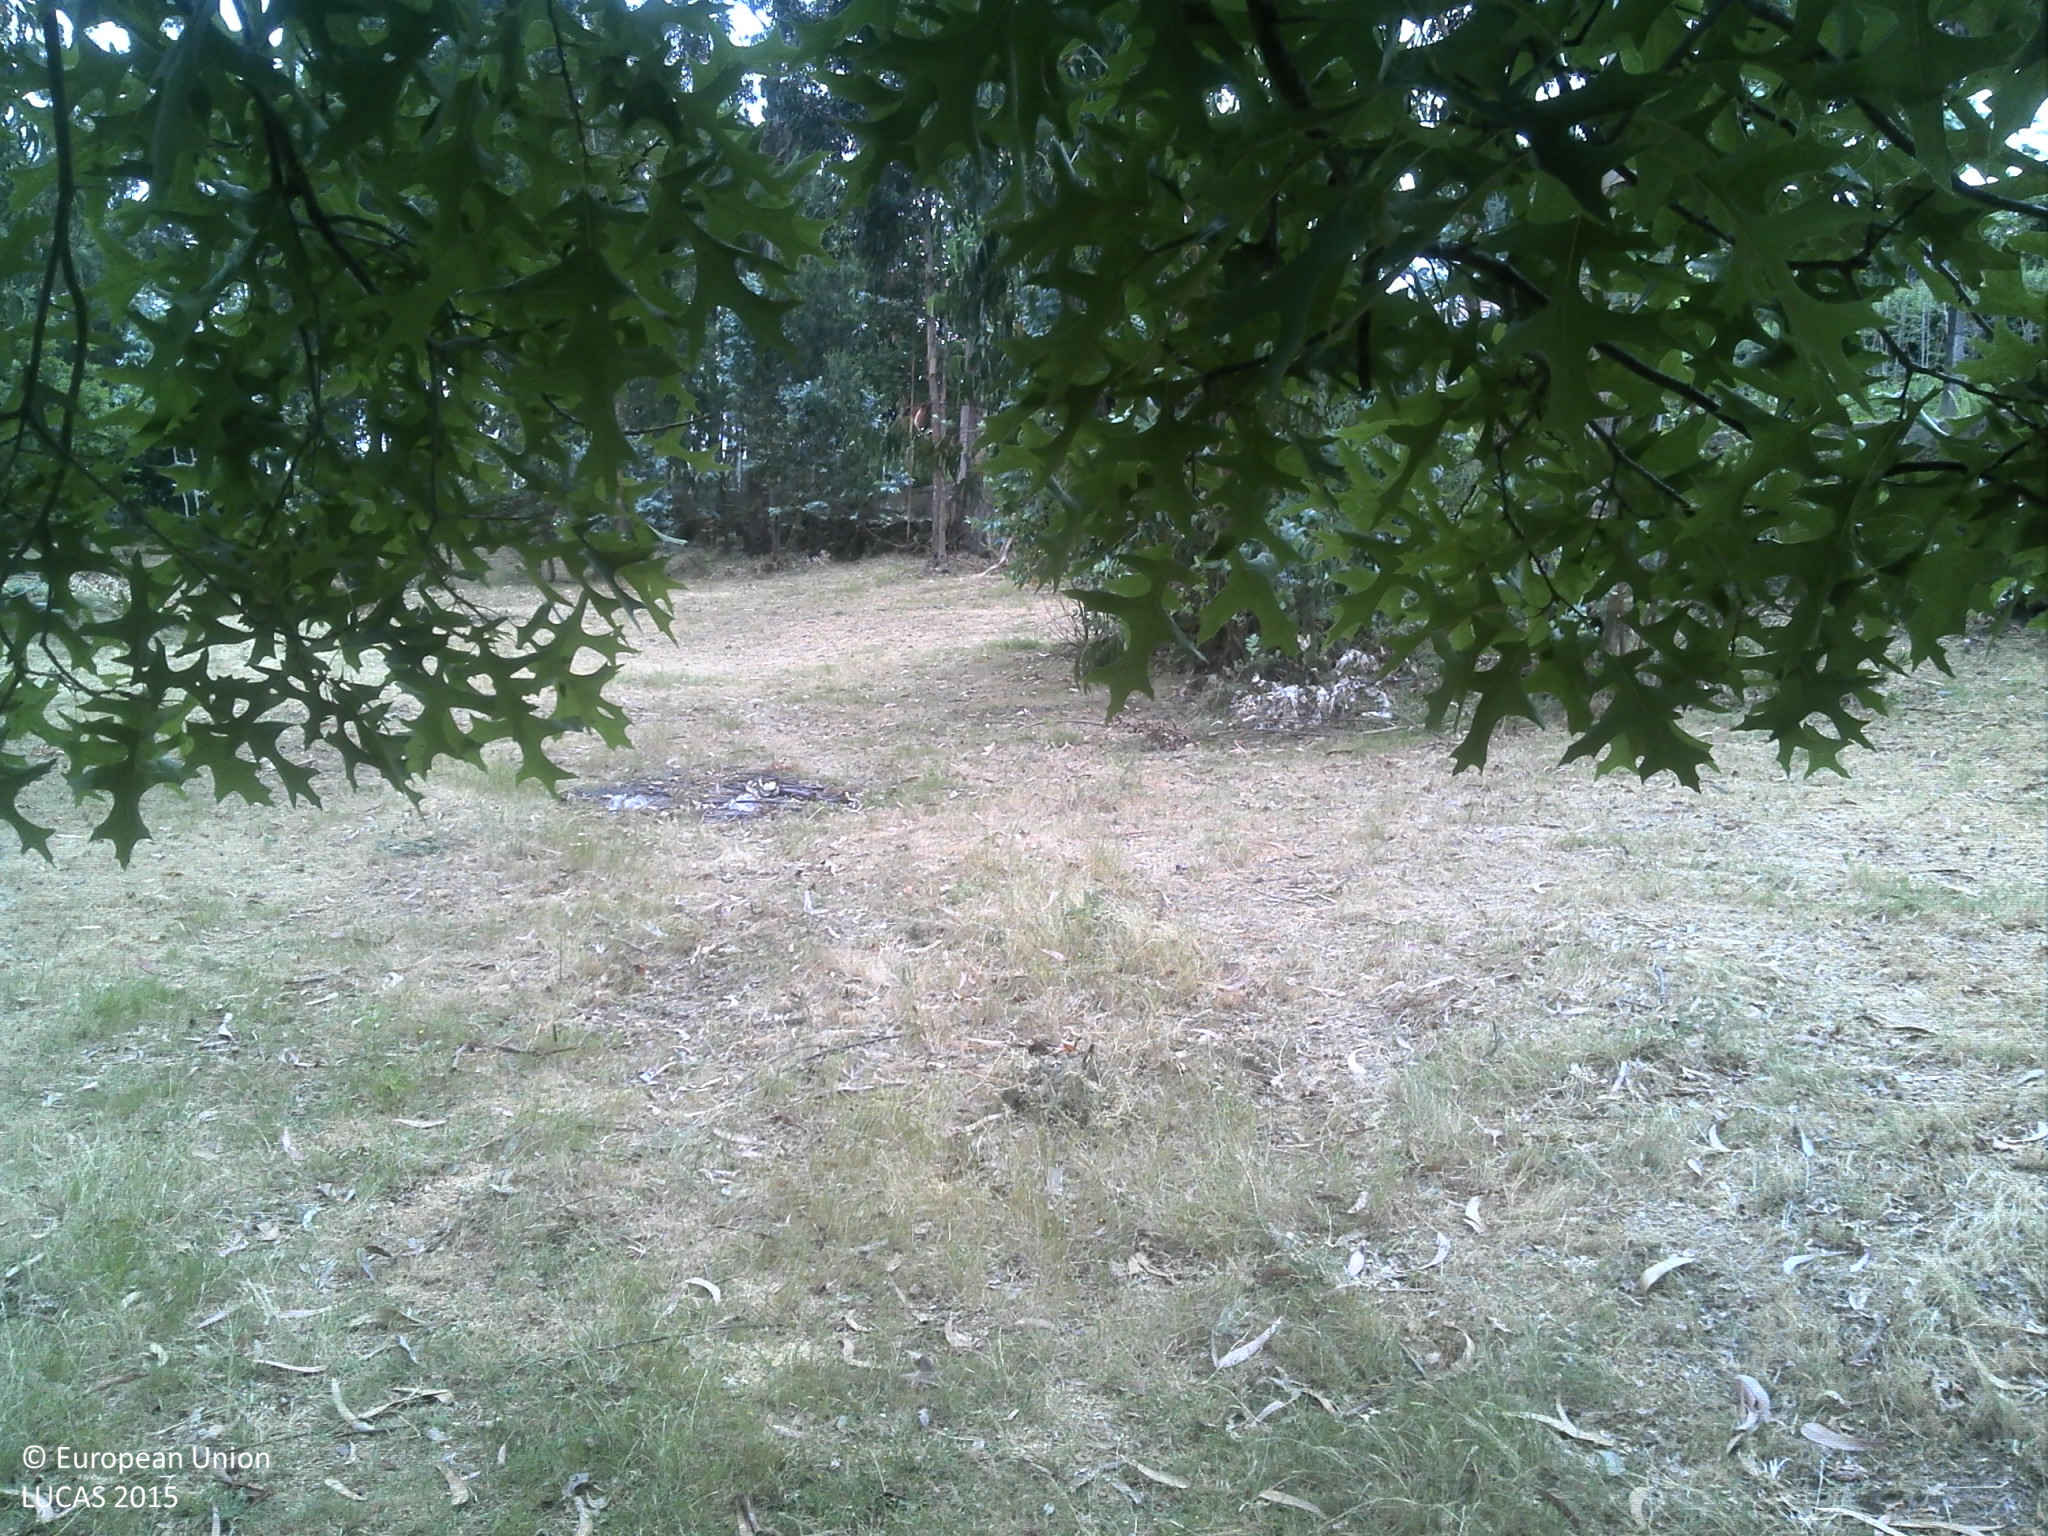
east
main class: Woodland
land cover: Broadleaved woodland
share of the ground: > 75 %
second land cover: Grassland without tree/shrub cover
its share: 10 - 25 %
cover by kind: broadleaved forest trees 75 %, unconsolidated bare surface 15 %, herbaceous plants 10 %
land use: Forestry
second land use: Agriculture (excluding fallow land and kitchen gardens)
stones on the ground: < 10 %
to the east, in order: Broadleaved woodland; Grassland without tree/shrub cover; Broadleaved woodland; Dry stone walls; Other fresh vegetables; Artificial constructions in urban areas; Shrubland without tree cover; Tracks; Broadleaved woodland; Shrubland without tree cover
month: June
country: PT
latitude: 41.1602
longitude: -8.1710
